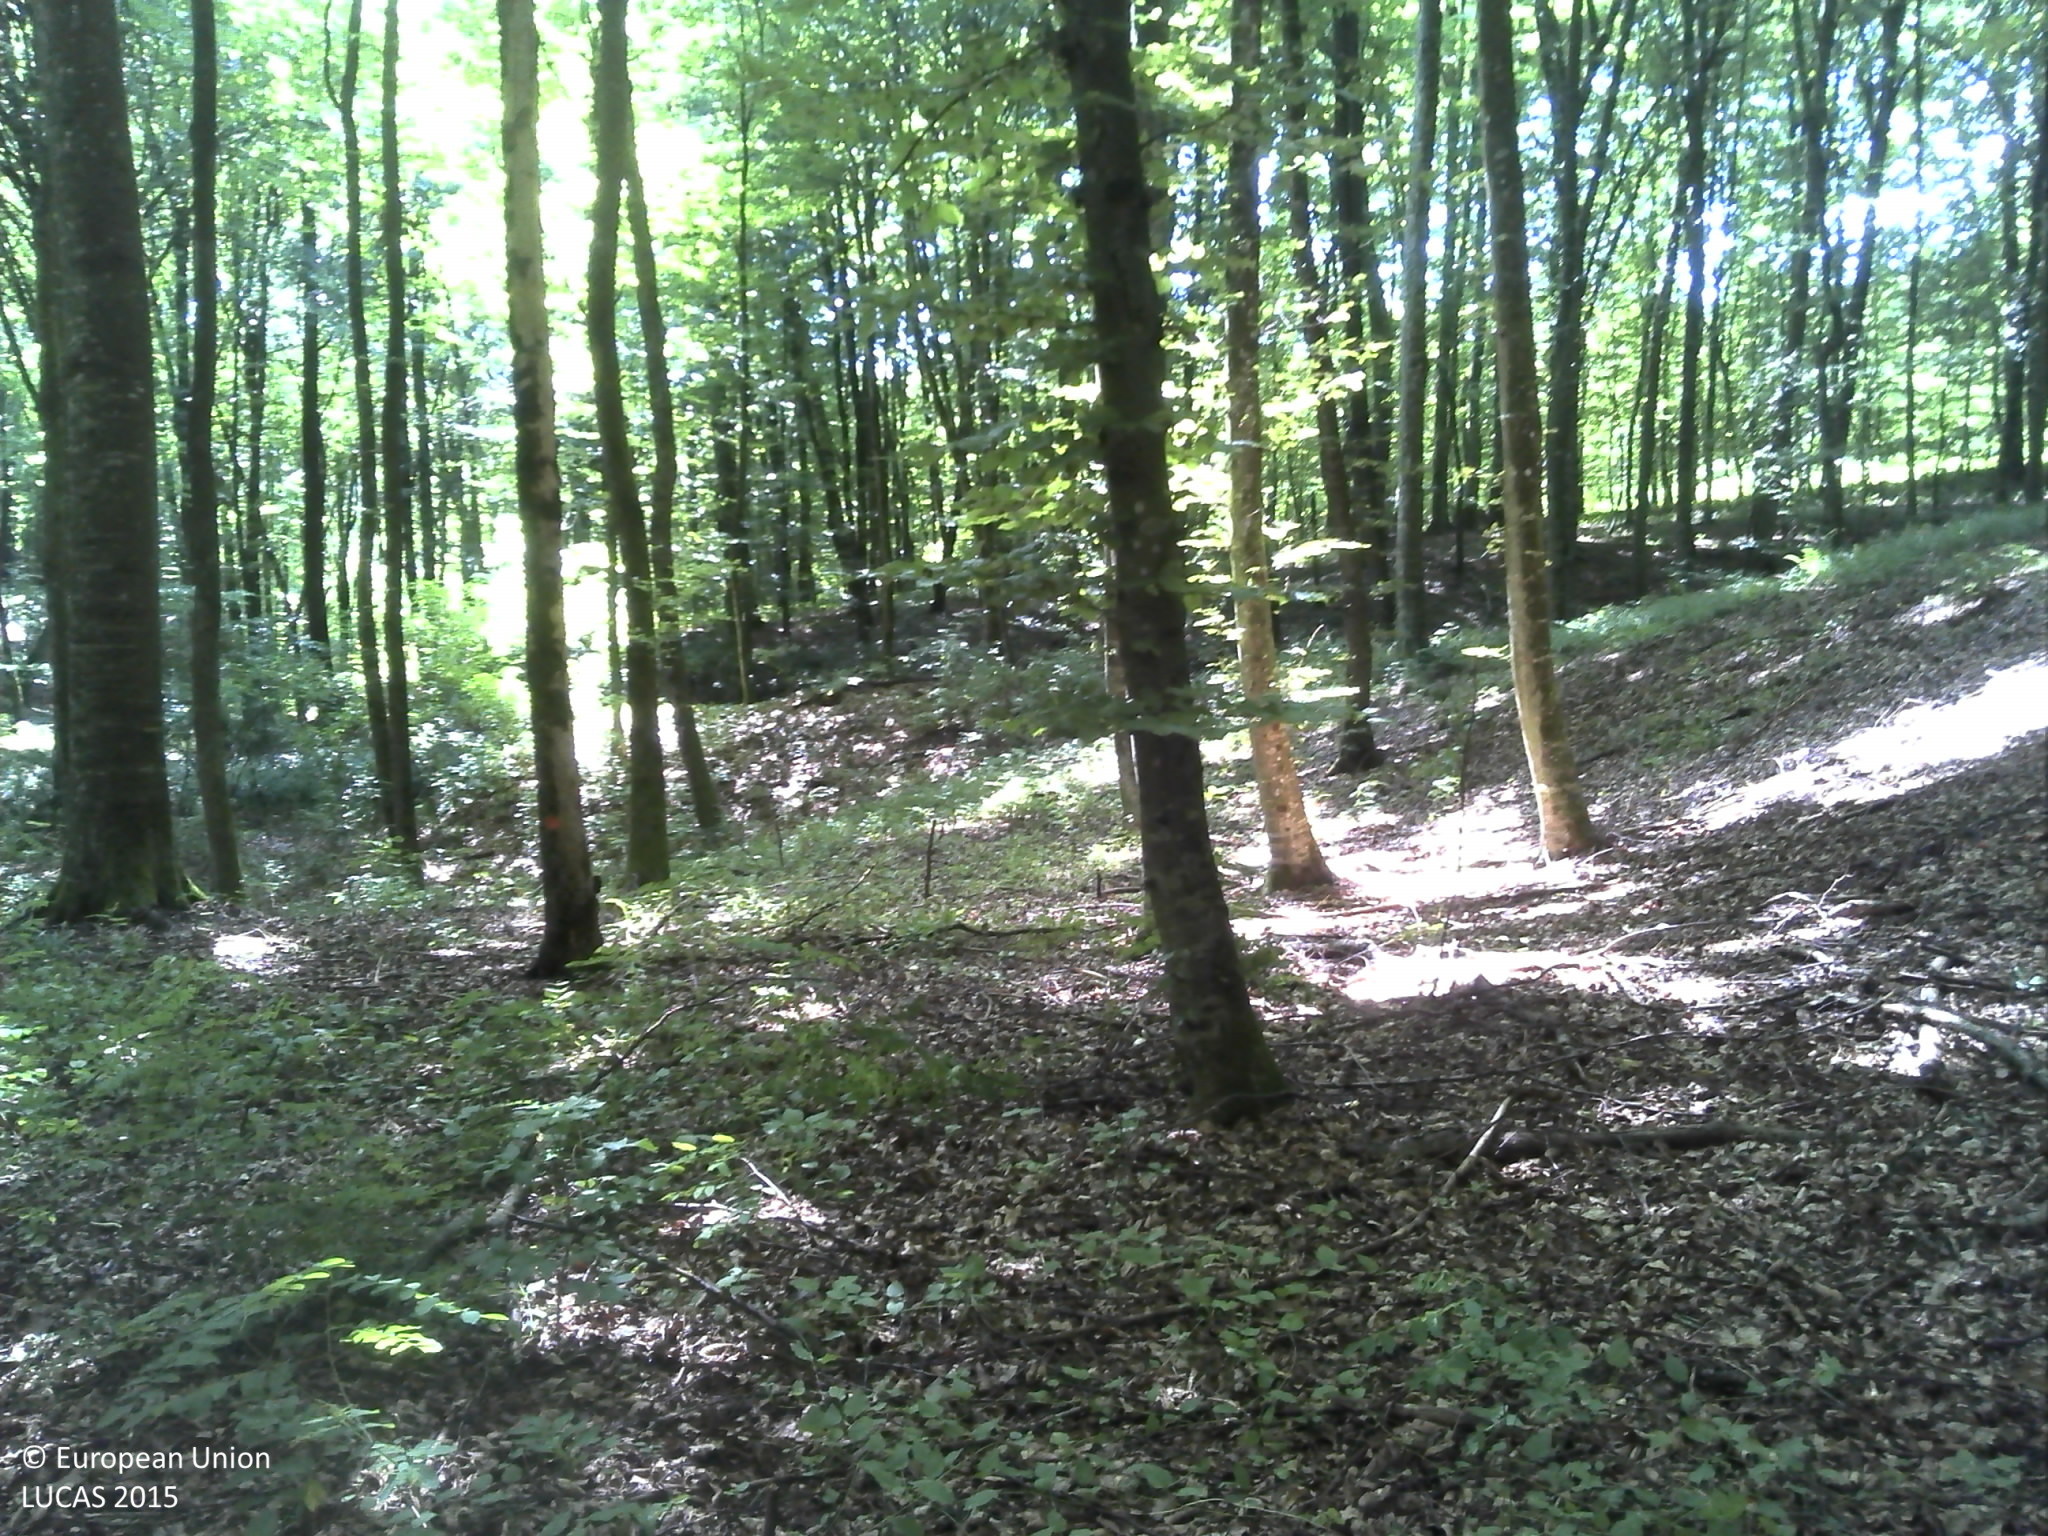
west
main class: Woodland
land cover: Broadleaved woodland
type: acidophilous oak and oak-birch forest
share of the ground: > 75 %
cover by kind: broadleaved forest trees 90 %, shrubs 5 %, herbaceous plants 5 %
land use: Forestry
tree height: > 5 m
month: July
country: HR
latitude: 45.5505
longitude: 17.1607
